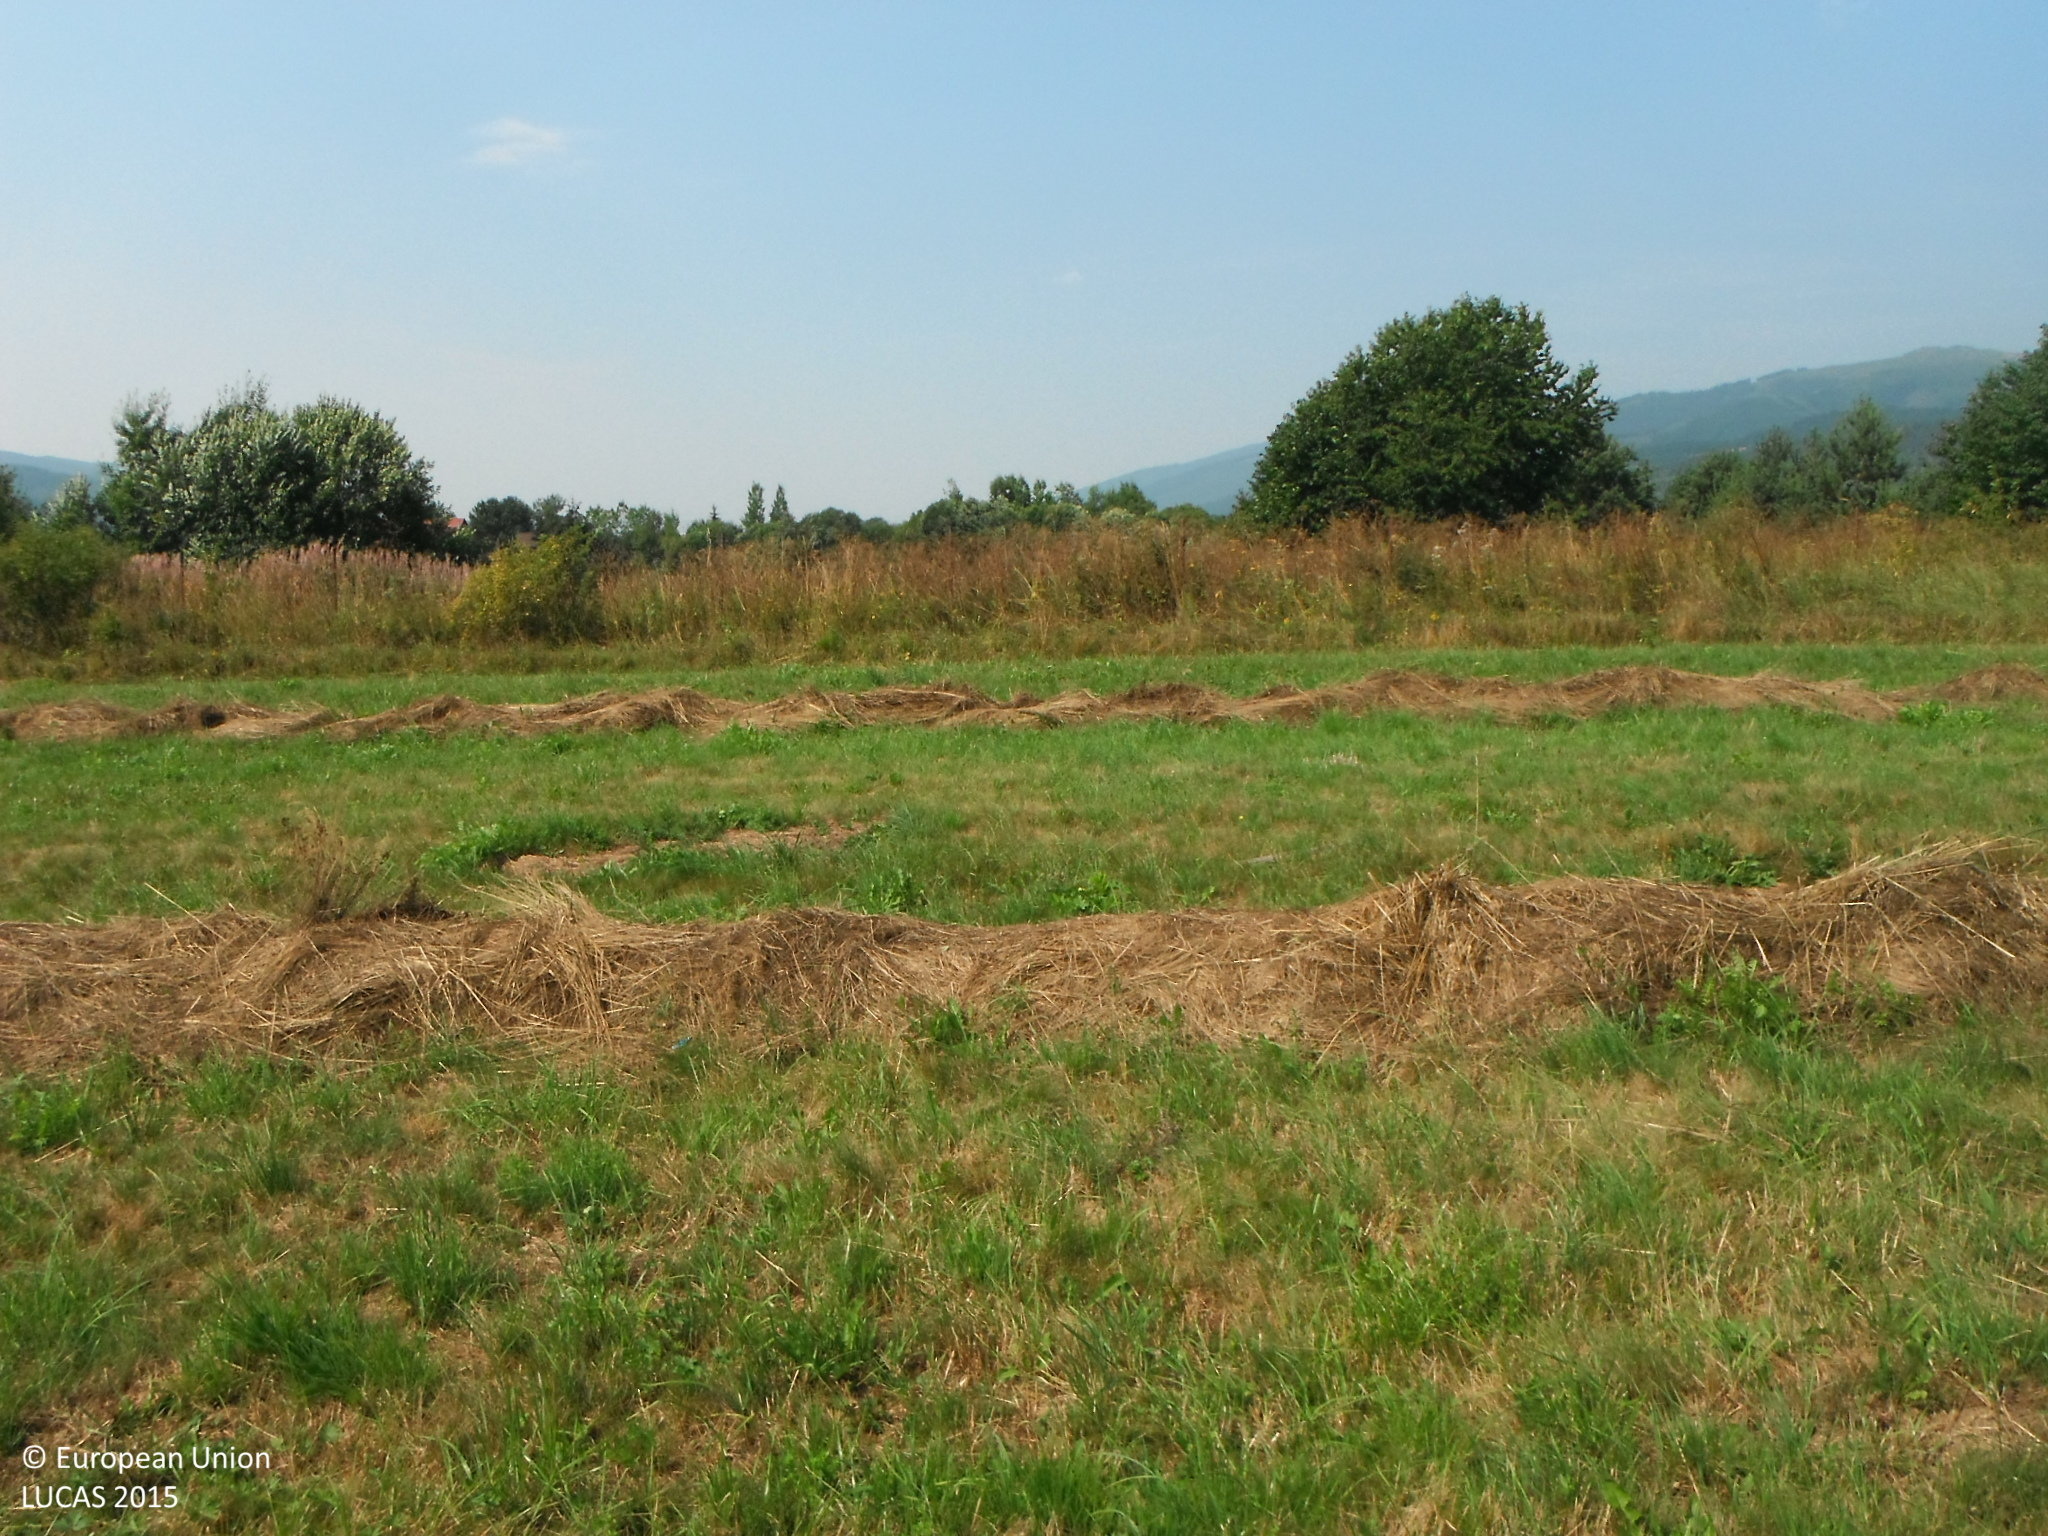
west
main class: Grassland
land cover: Grassland without tree/shrub cover
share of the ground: > 75 %
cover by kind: herbaceous plants 100 %
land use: Agriculture (excluding fallow land and kitchen gardens)
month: August
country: SK
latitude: 48.8633
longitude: 19.9124
